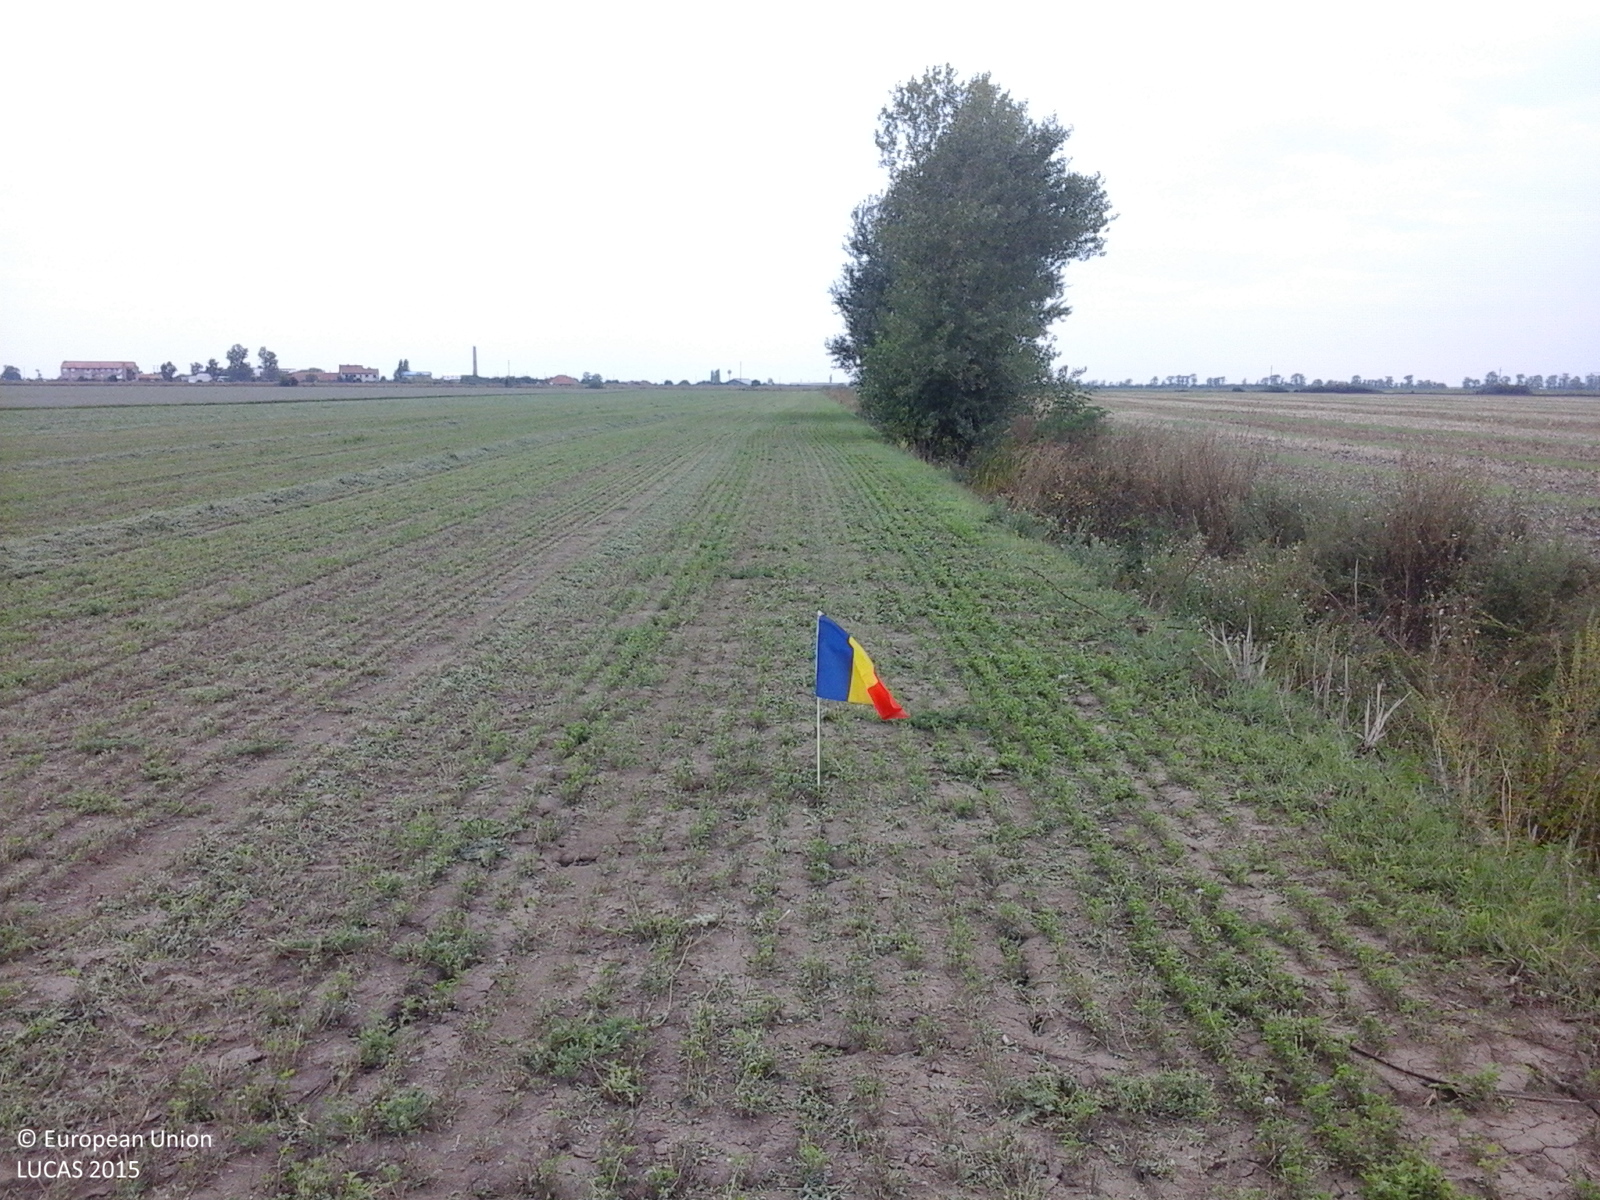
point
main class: Cropland
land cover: Lucerne
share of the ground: 50 - 75 %
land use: Agriculture (excluding fallow land and kitchen gardens)
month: August
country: RO
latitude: 46.2667
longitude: 21.2307
